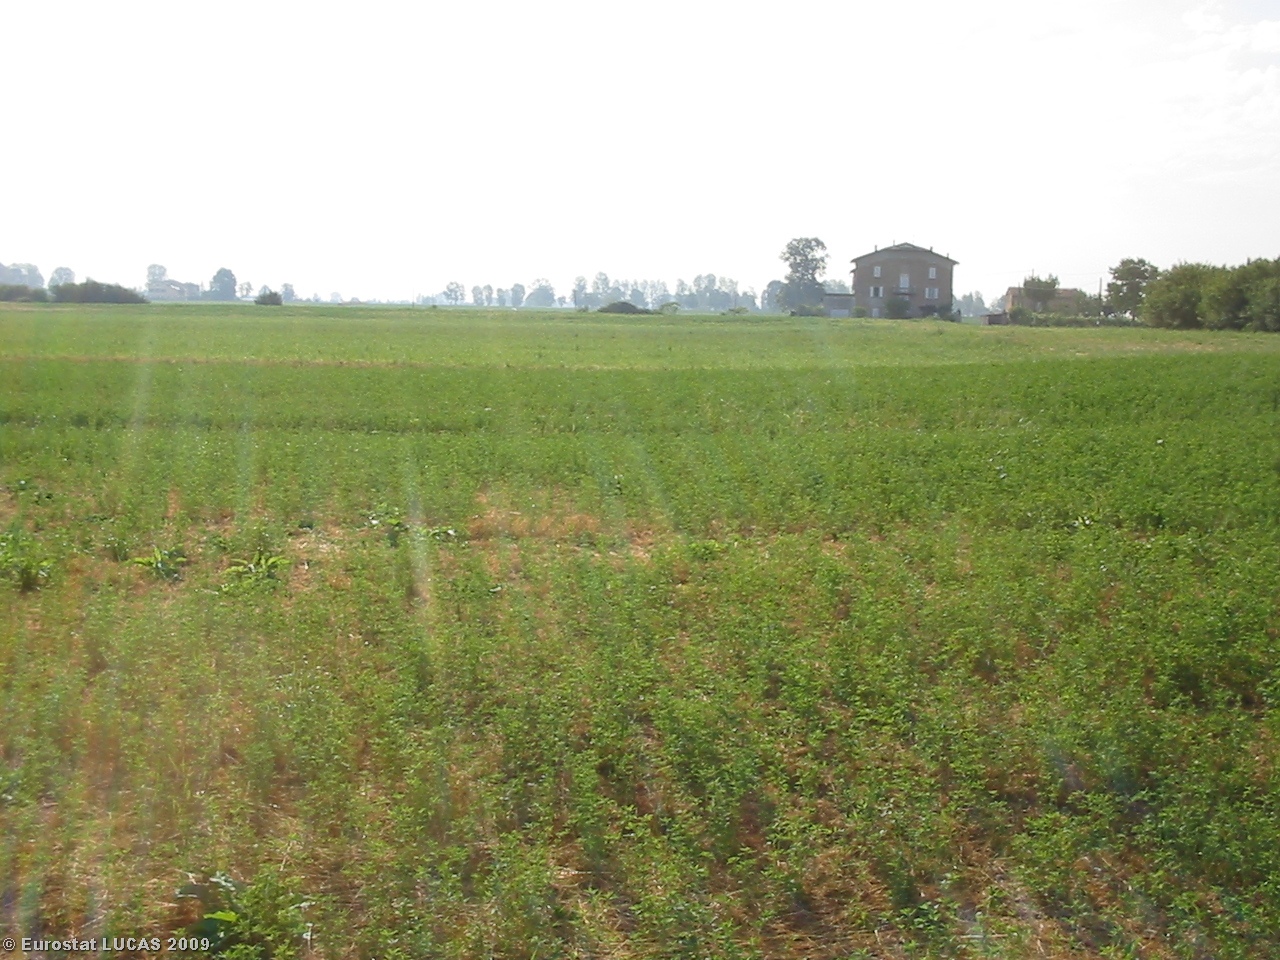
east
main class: Cropland
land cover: Lucerne
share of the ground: > 75 %
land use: Agriculture (excluding fallow land and kitchen gardens)
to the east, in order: Lucerne; Ditches and canals; Lucerne; Ditches and canals; Lucerne; Ditches and canals; Lucerne; Ditches and canals; Lucerne; Ditches and canals; Paved roads, cycling and walking lanes; Grass margins; Ditches and canals; Lucerne
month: June
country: IT
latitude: 44.8184
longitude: 10.4669
